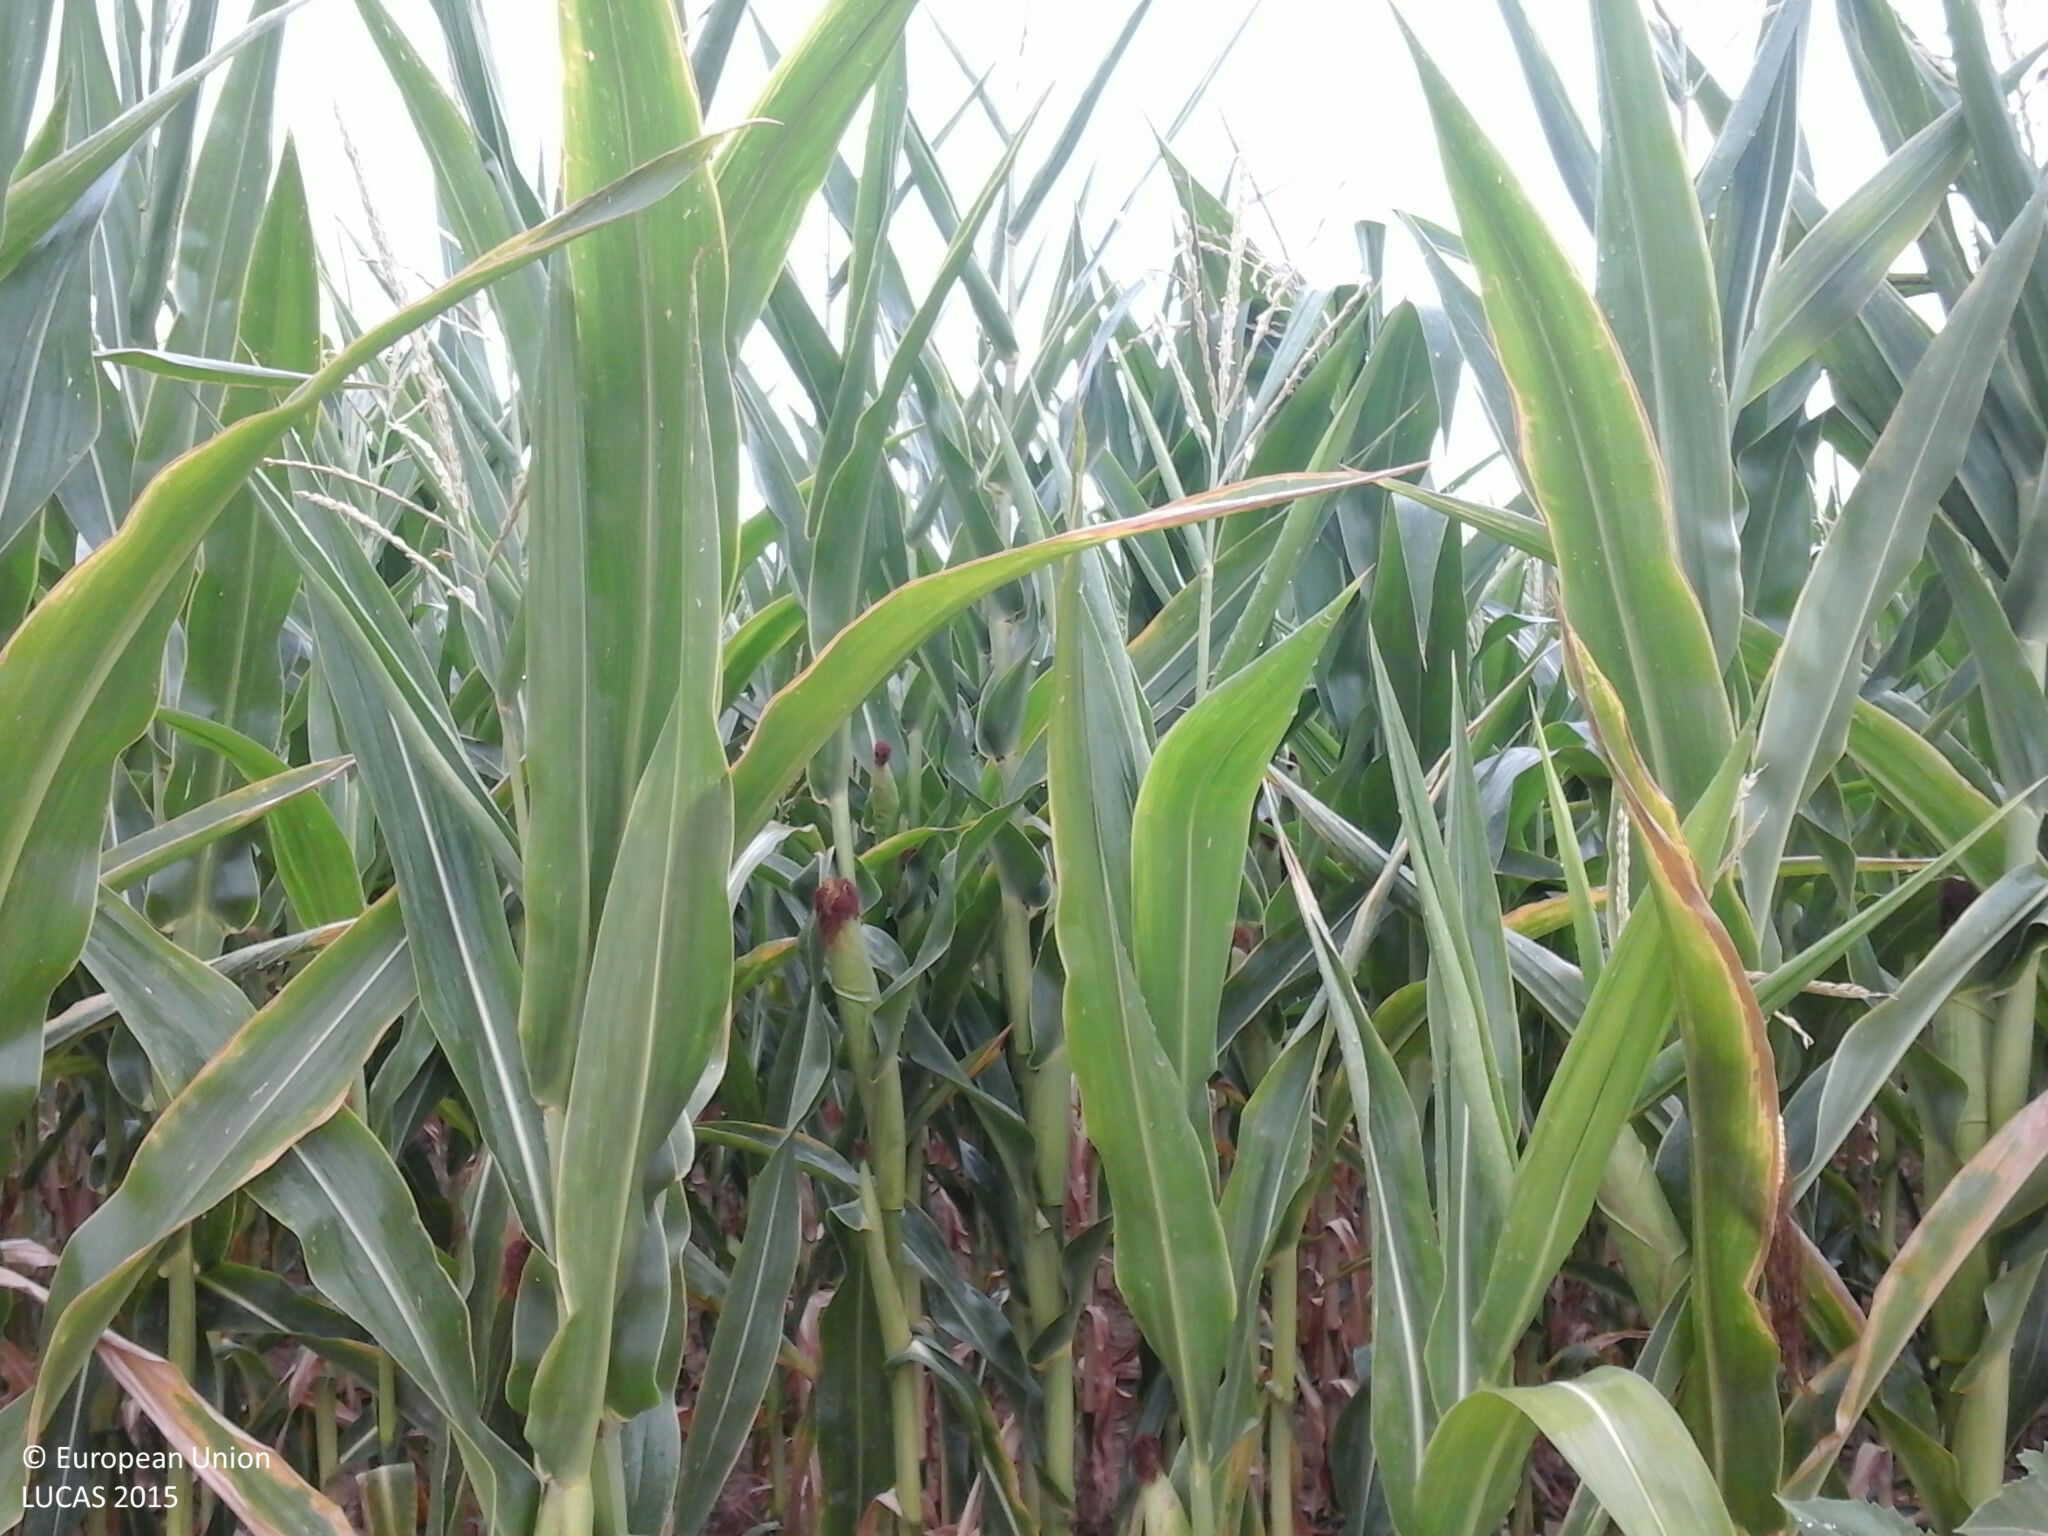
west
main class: Cropland
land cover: Maize
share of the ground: > 75 %
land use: Agriculture (excluding fallow land and kitchen gardens)
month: July
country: HU
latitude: 47.9271
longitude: 19.4313
